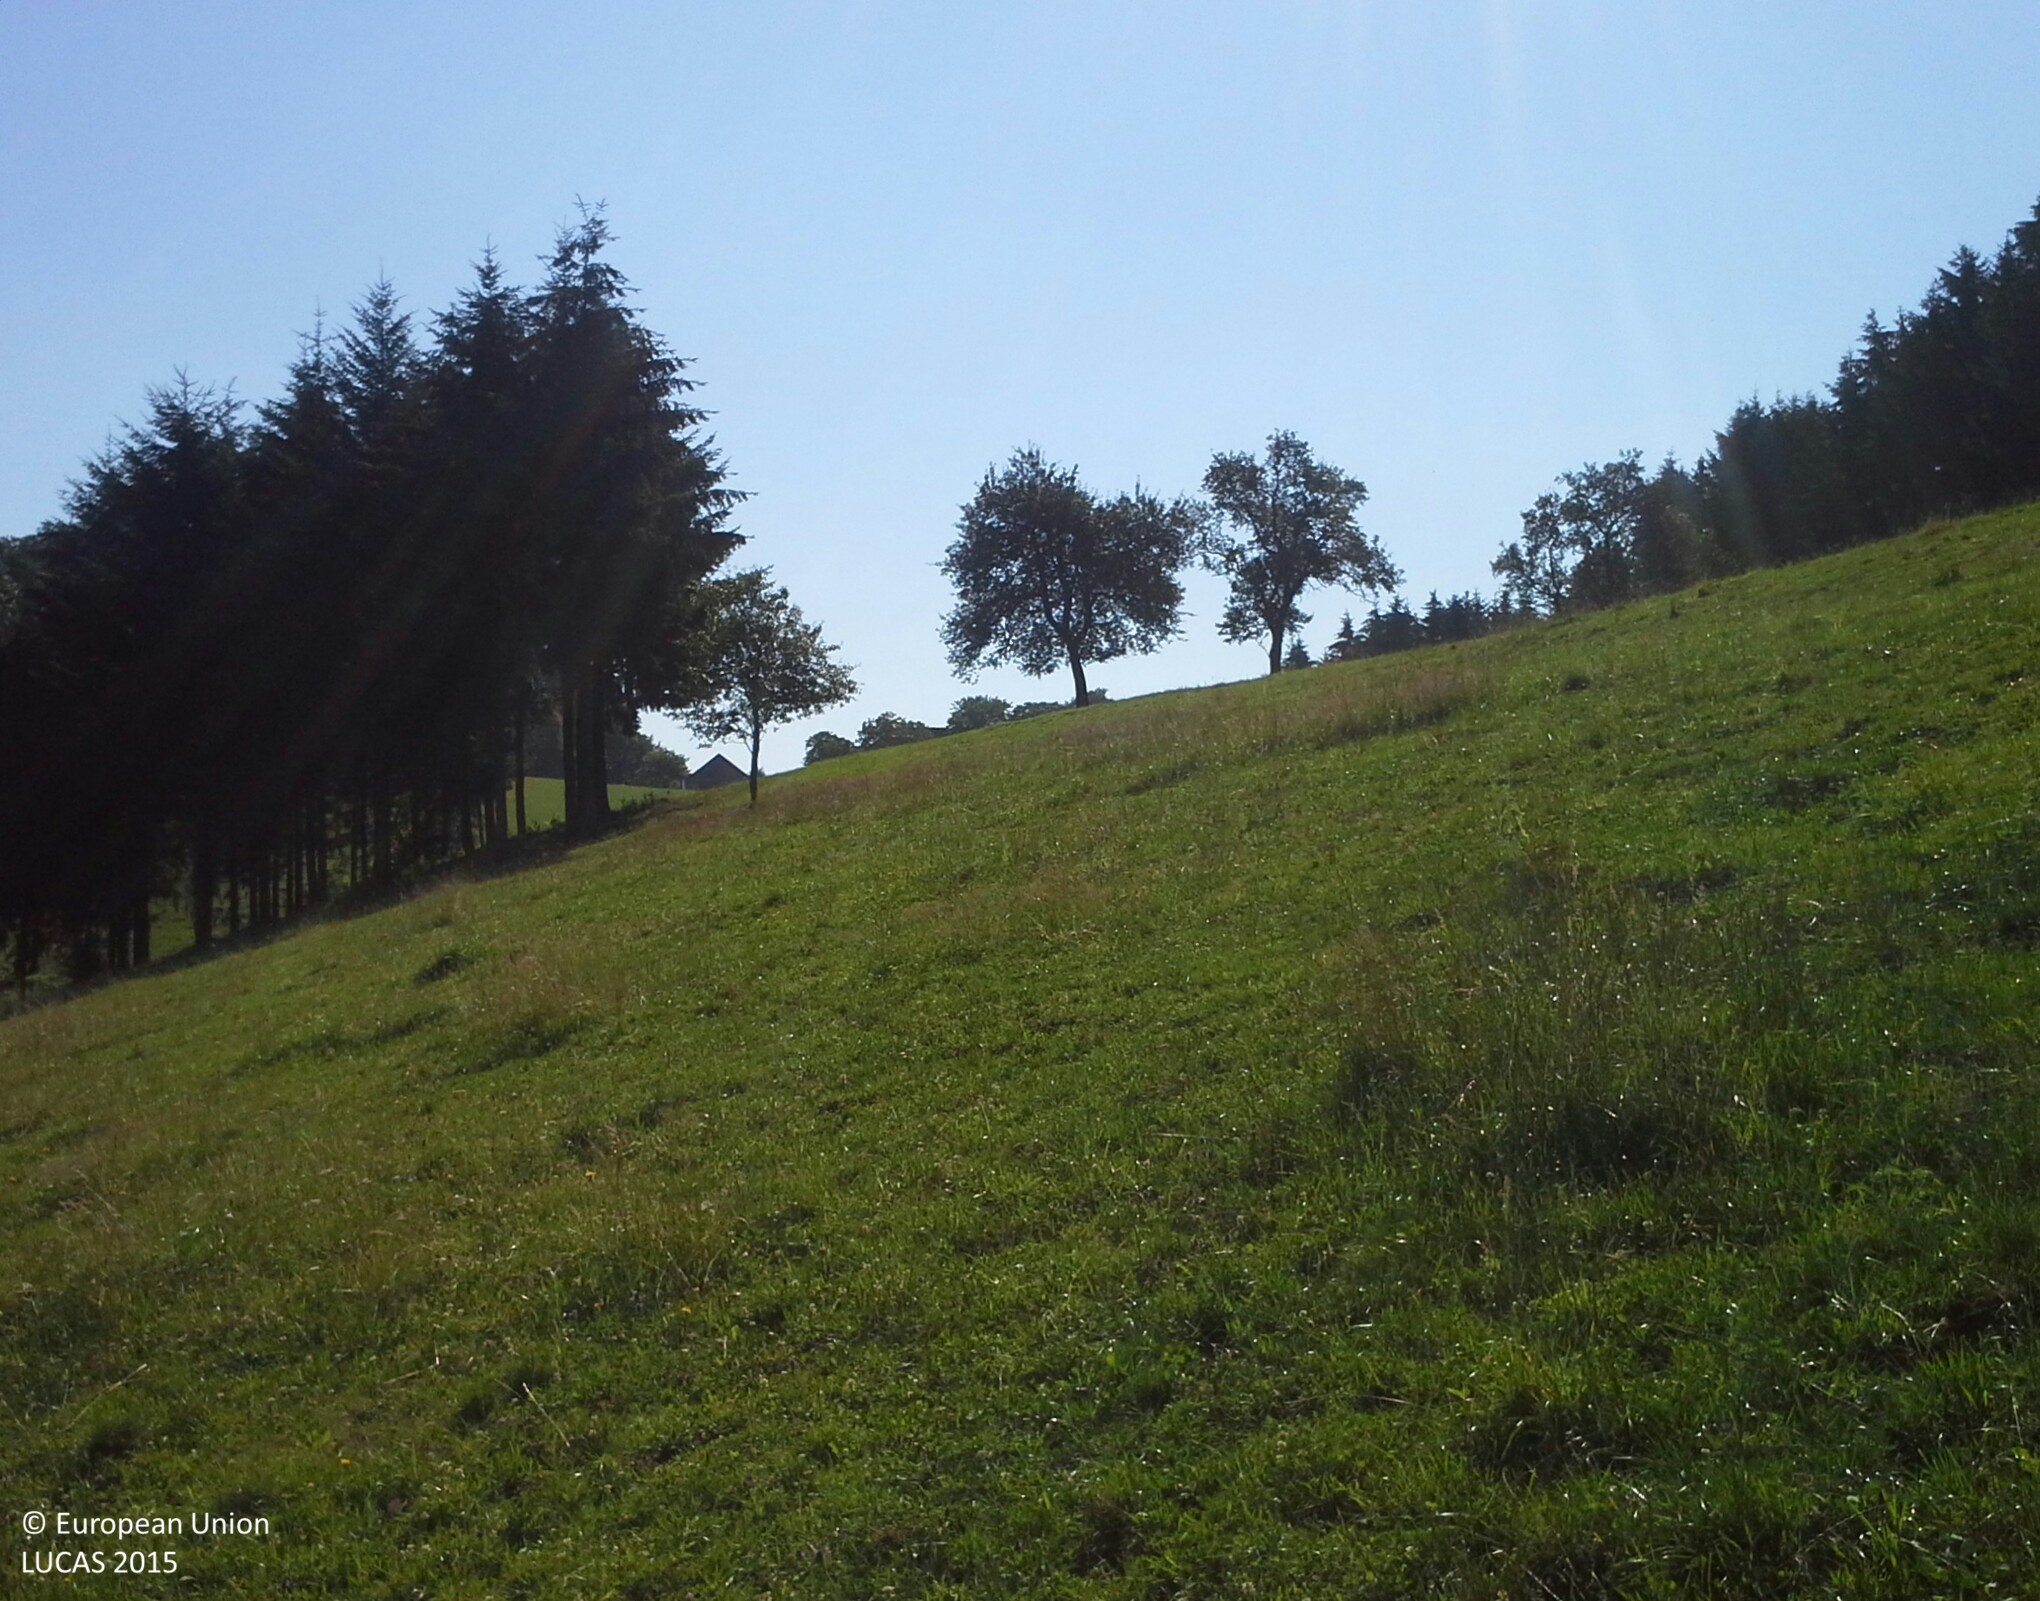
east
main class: Grassland
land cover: Grassland without tree/shrub cover
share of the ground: > 75 %
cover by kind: herbaceous plants 100 %
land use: Agriculture (excluding fallow land and kitchen gardens)
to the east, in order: Grassland without tree/shrub cover; Tracks; Grassland with sparse tree/shrub cover; Grassland without tree/shrub cover
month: July
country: AT
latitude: 48.1887
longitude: 14.8569
